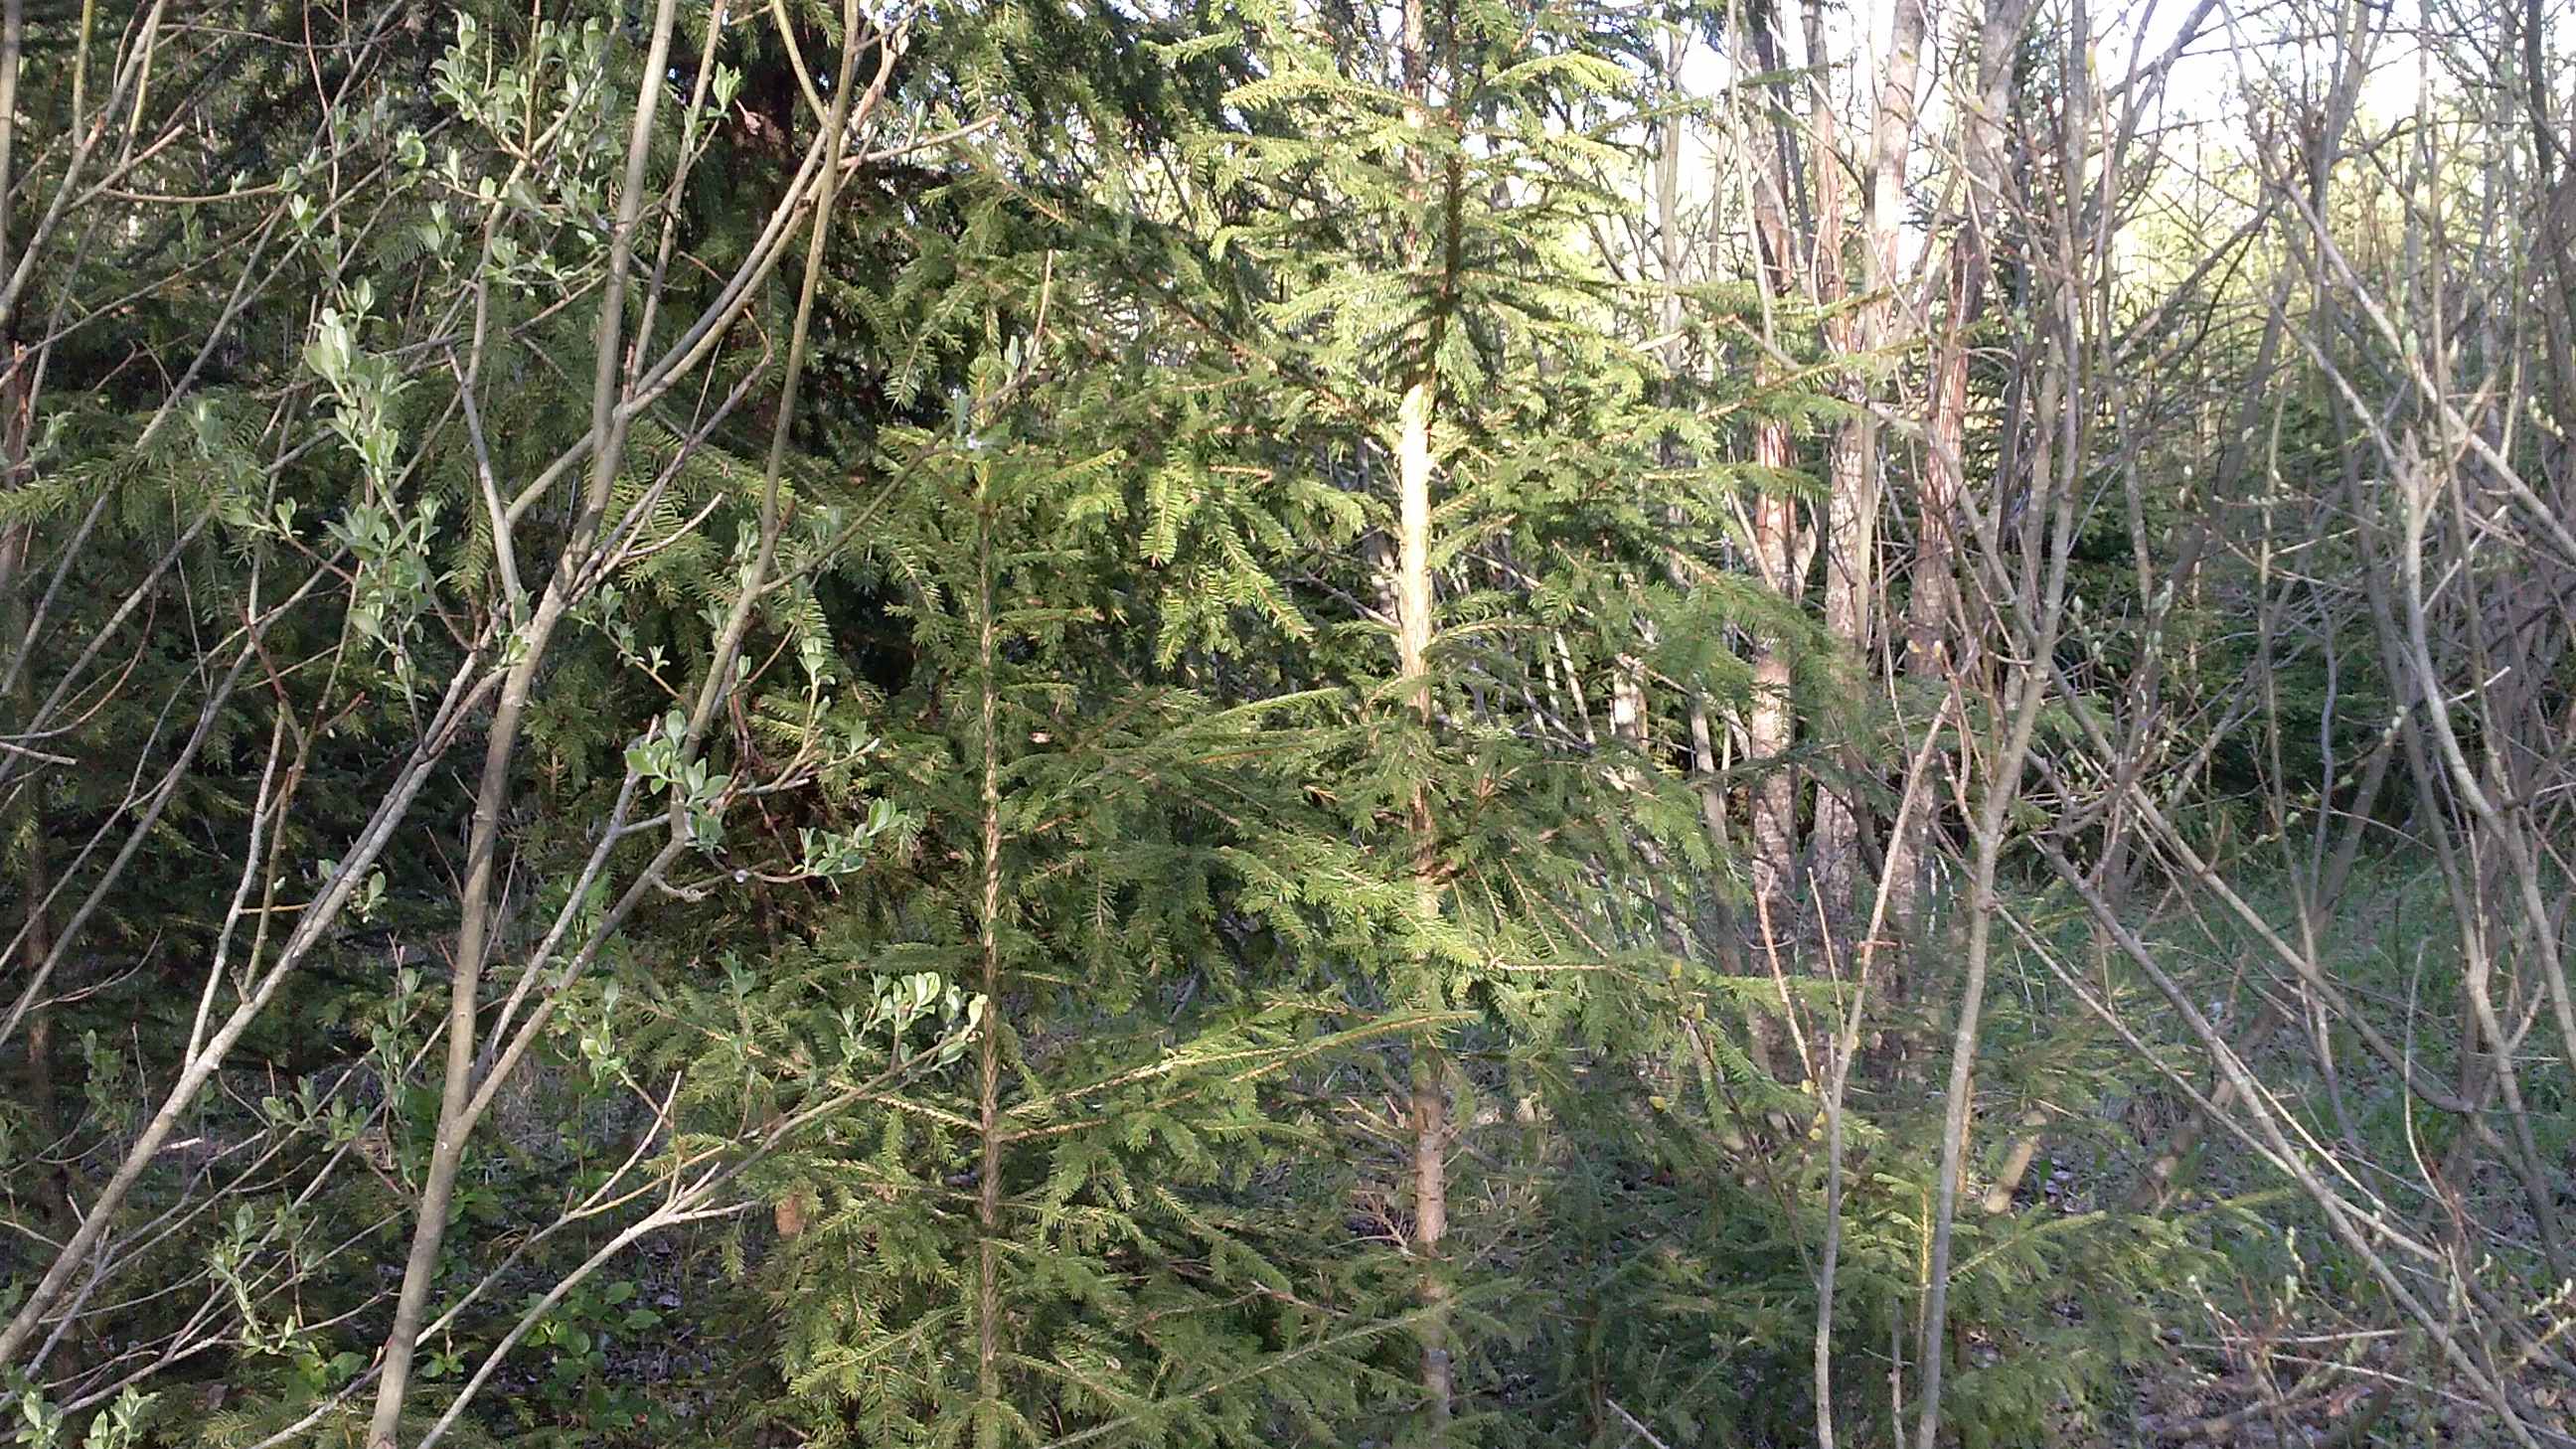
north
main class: Woodland
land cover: Spruce dominated mixed woodland
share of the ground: > 75 %
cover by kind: coniferous forest trees 75 %, broadleaved forest trees 25 %
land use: Forestry
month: May
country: LV
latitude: 56.0926
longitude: 27.2591
